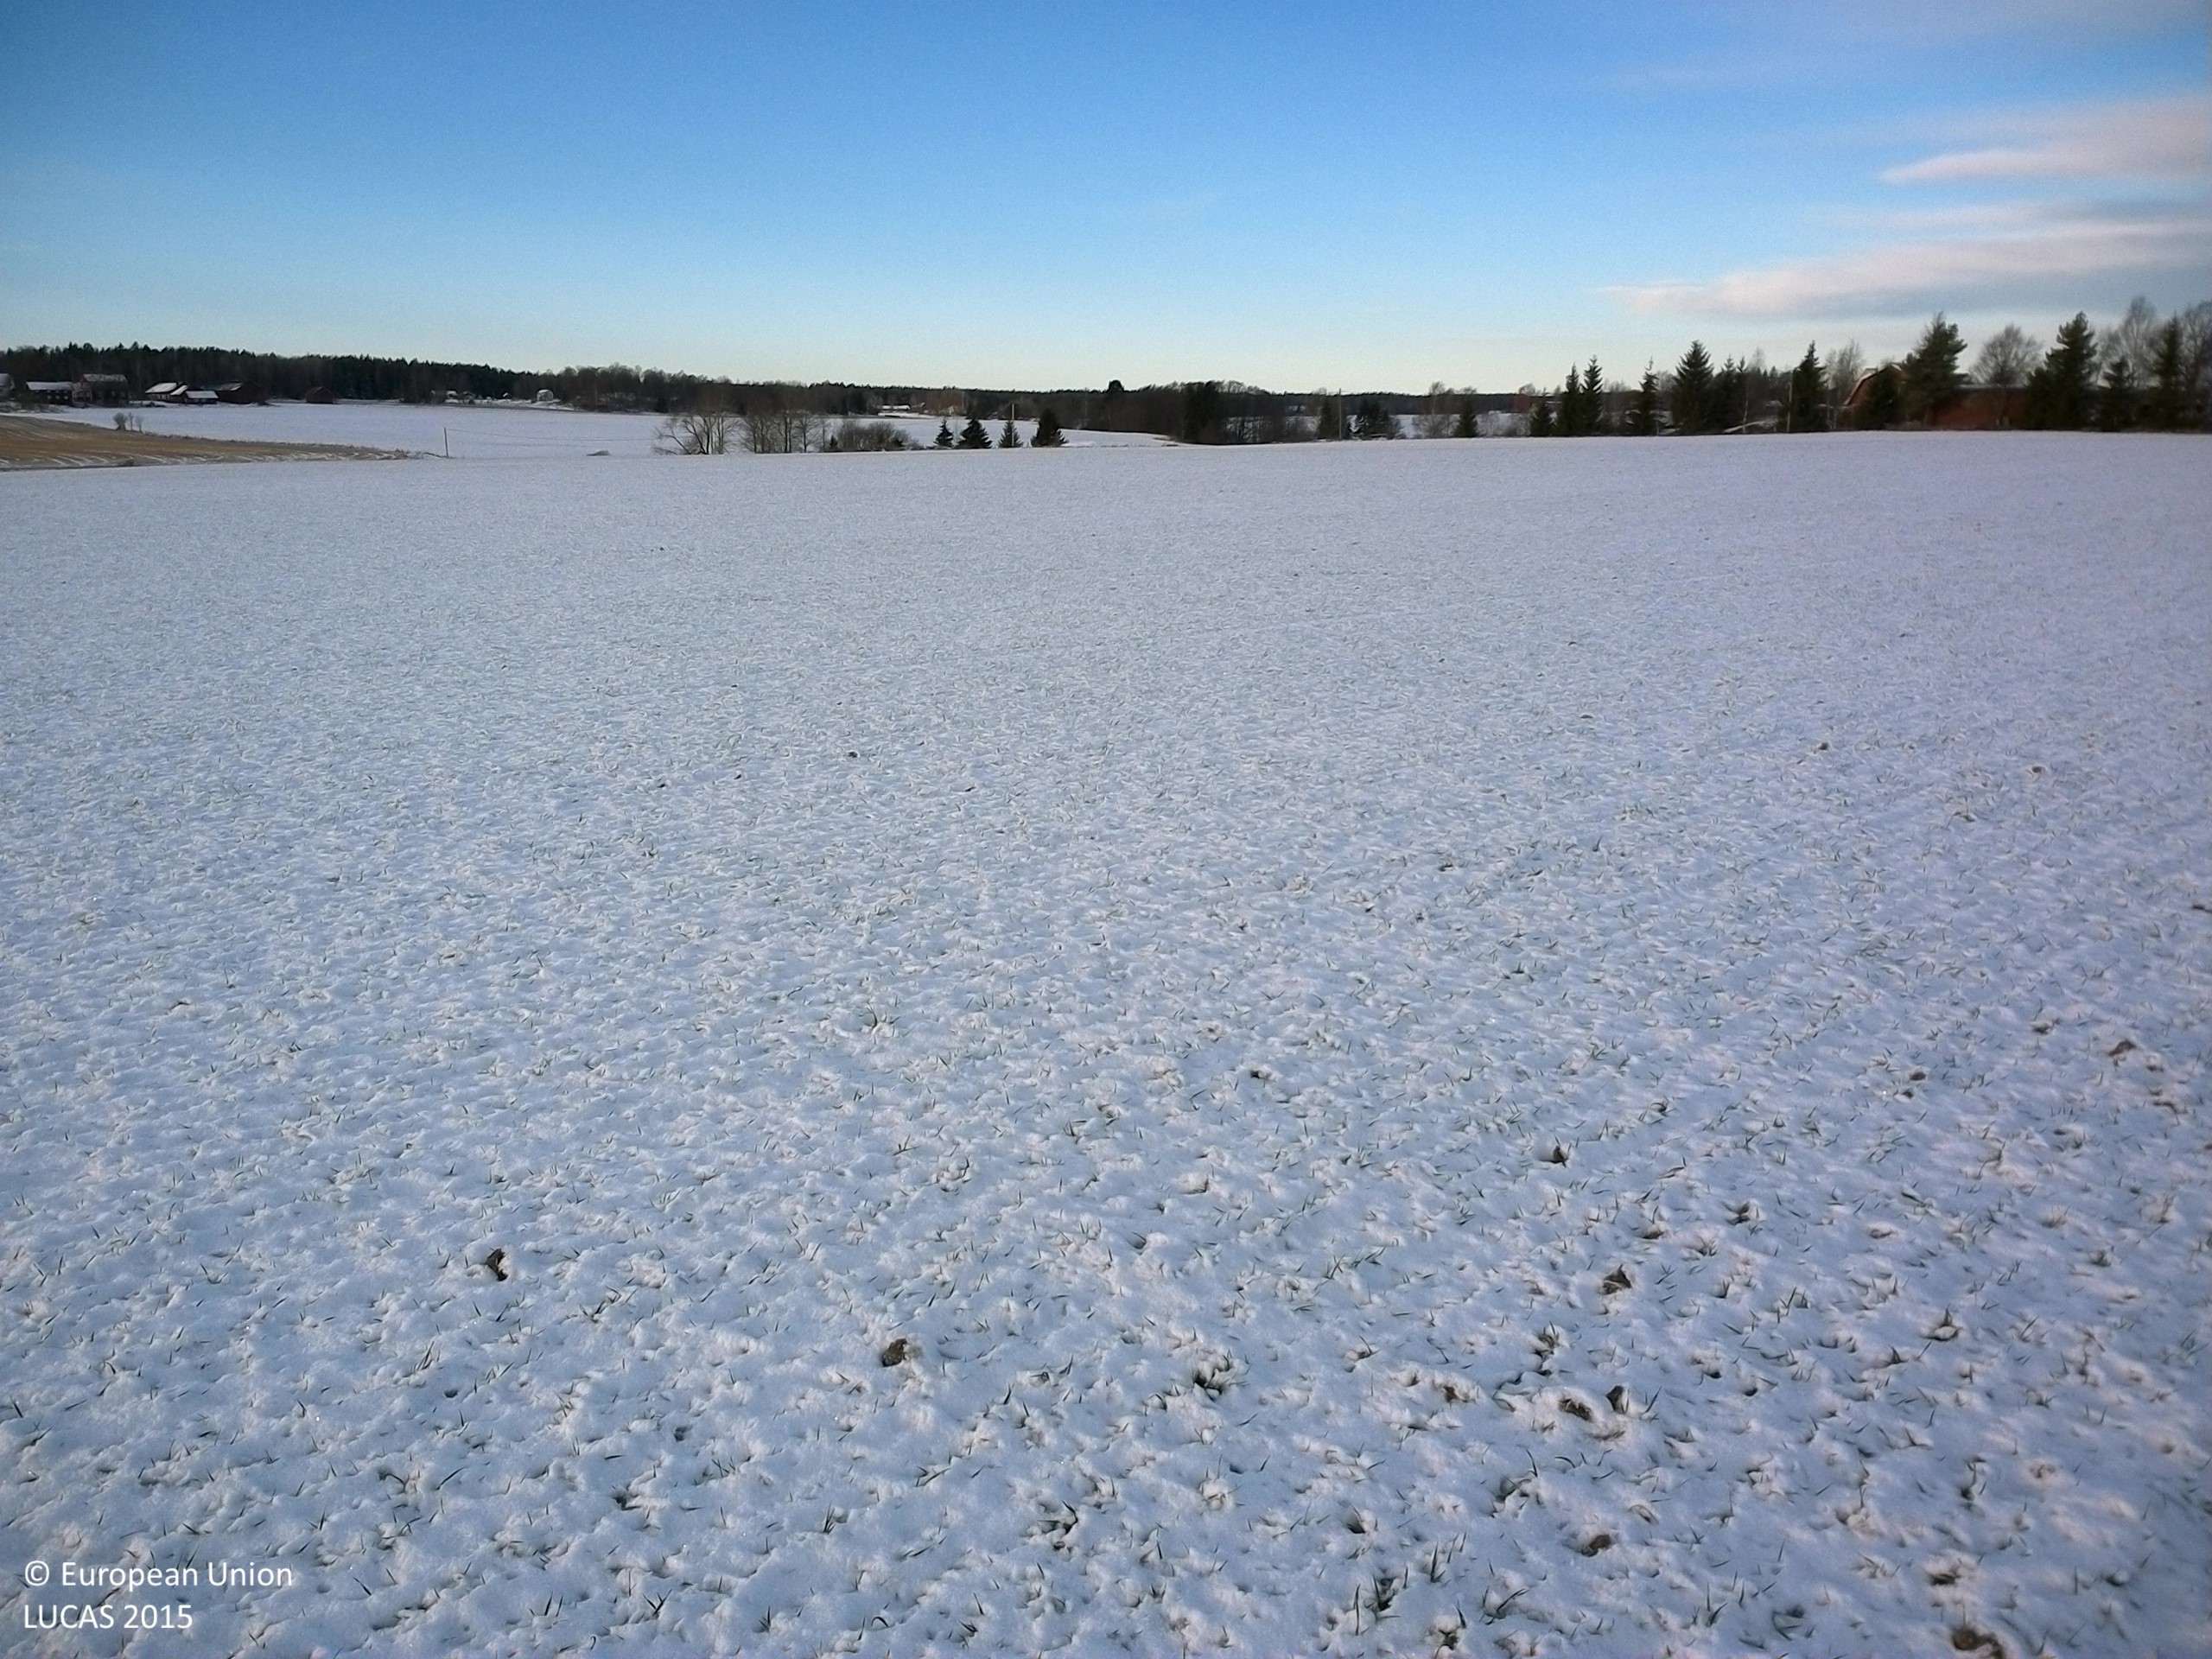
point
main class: Cropland
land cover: Common wheat
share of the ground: 10 - 25 %
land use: Agriculture (excluding fallow land and kitchen gardens)
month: December
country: SE
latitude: 59.6903
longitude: 16.4401
